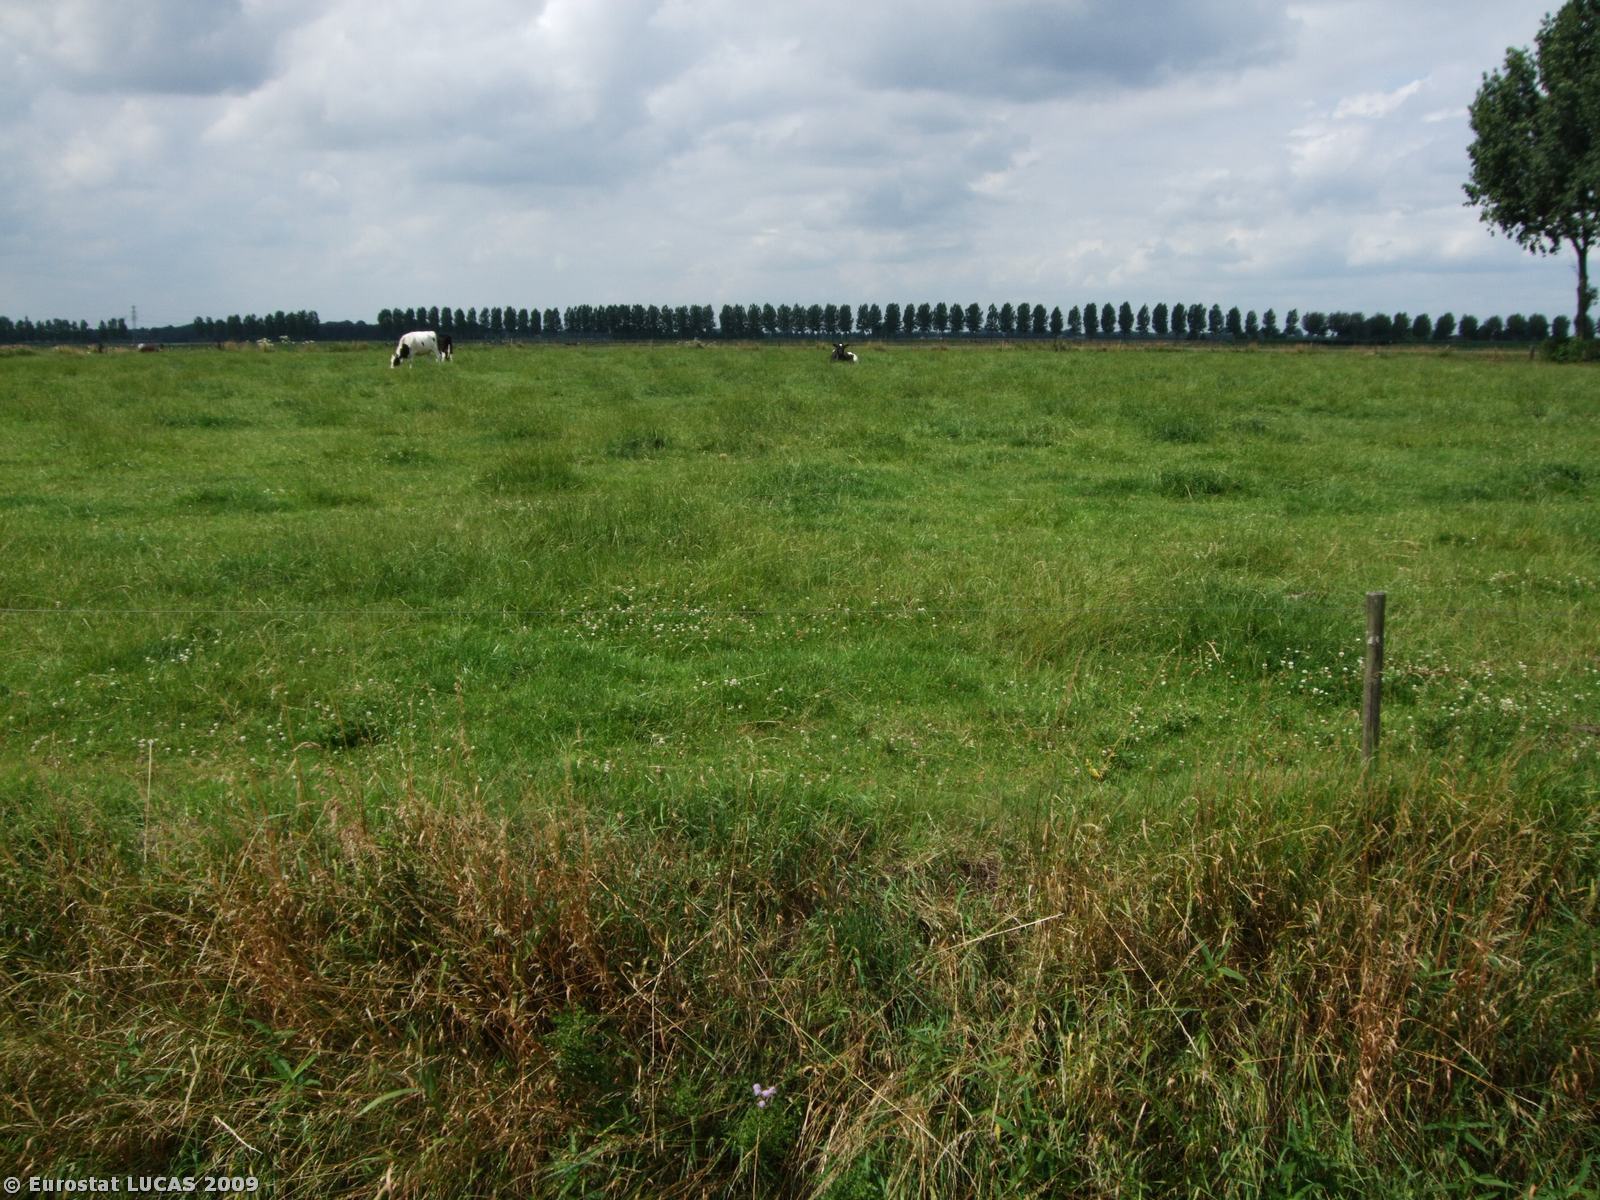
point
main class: Grassland
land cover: Grassland without tree/shrub cover
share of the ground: > 75 %
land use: Agriculture (excluding fallow land and kitchen gardens)
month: July
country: NL
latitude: 51.9267
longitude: 5.3591
